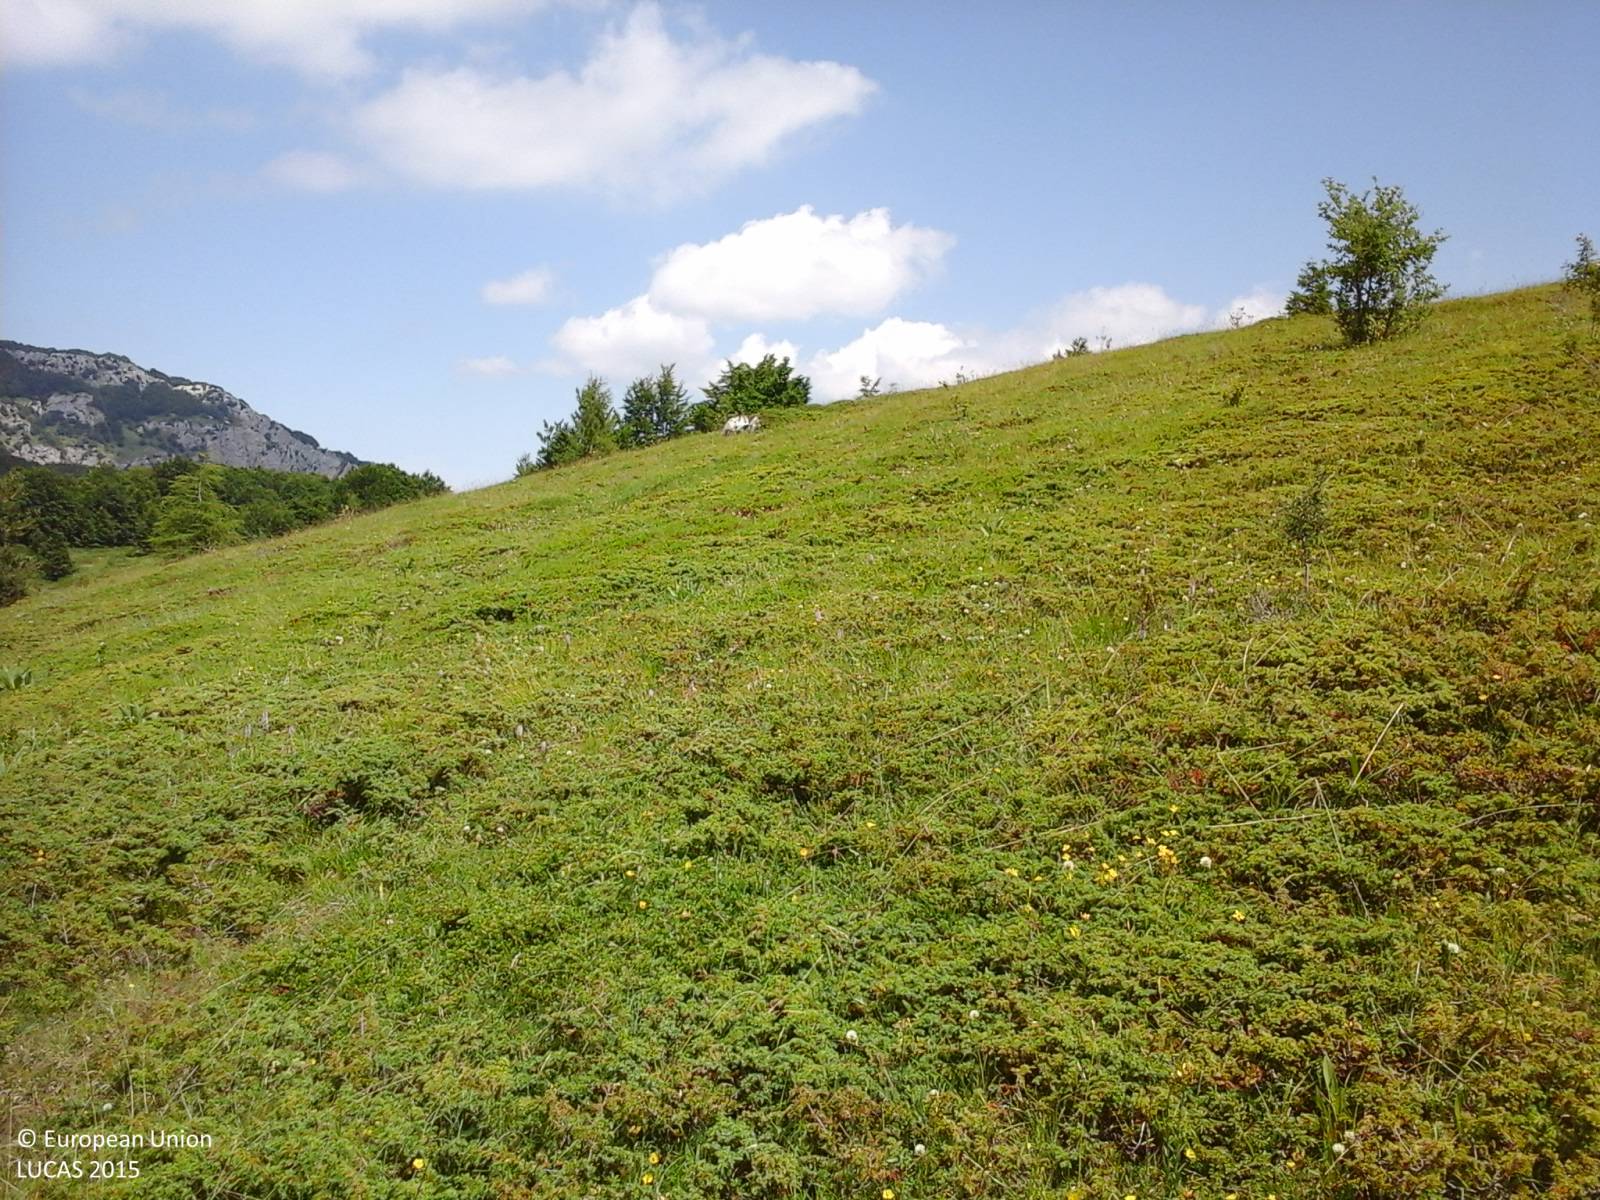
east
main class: Shrubland
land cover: Shrubland with sparse tree cover
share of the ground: > 75 %
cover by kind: shrubs 85 %, herbaceous plants 10 %, coniferous forest trees 5 %
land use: Semi-natural and natural areas not in use
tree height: < 5 m
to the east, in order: Shrubland with sparse tree cover; Shrubland without tree cover; Broadleaved woodland; Shrubland with sparse tree cover; Grassland with sparse tree/shrub cover
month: June
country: IT
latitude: 42.3851
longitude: 13.7658
